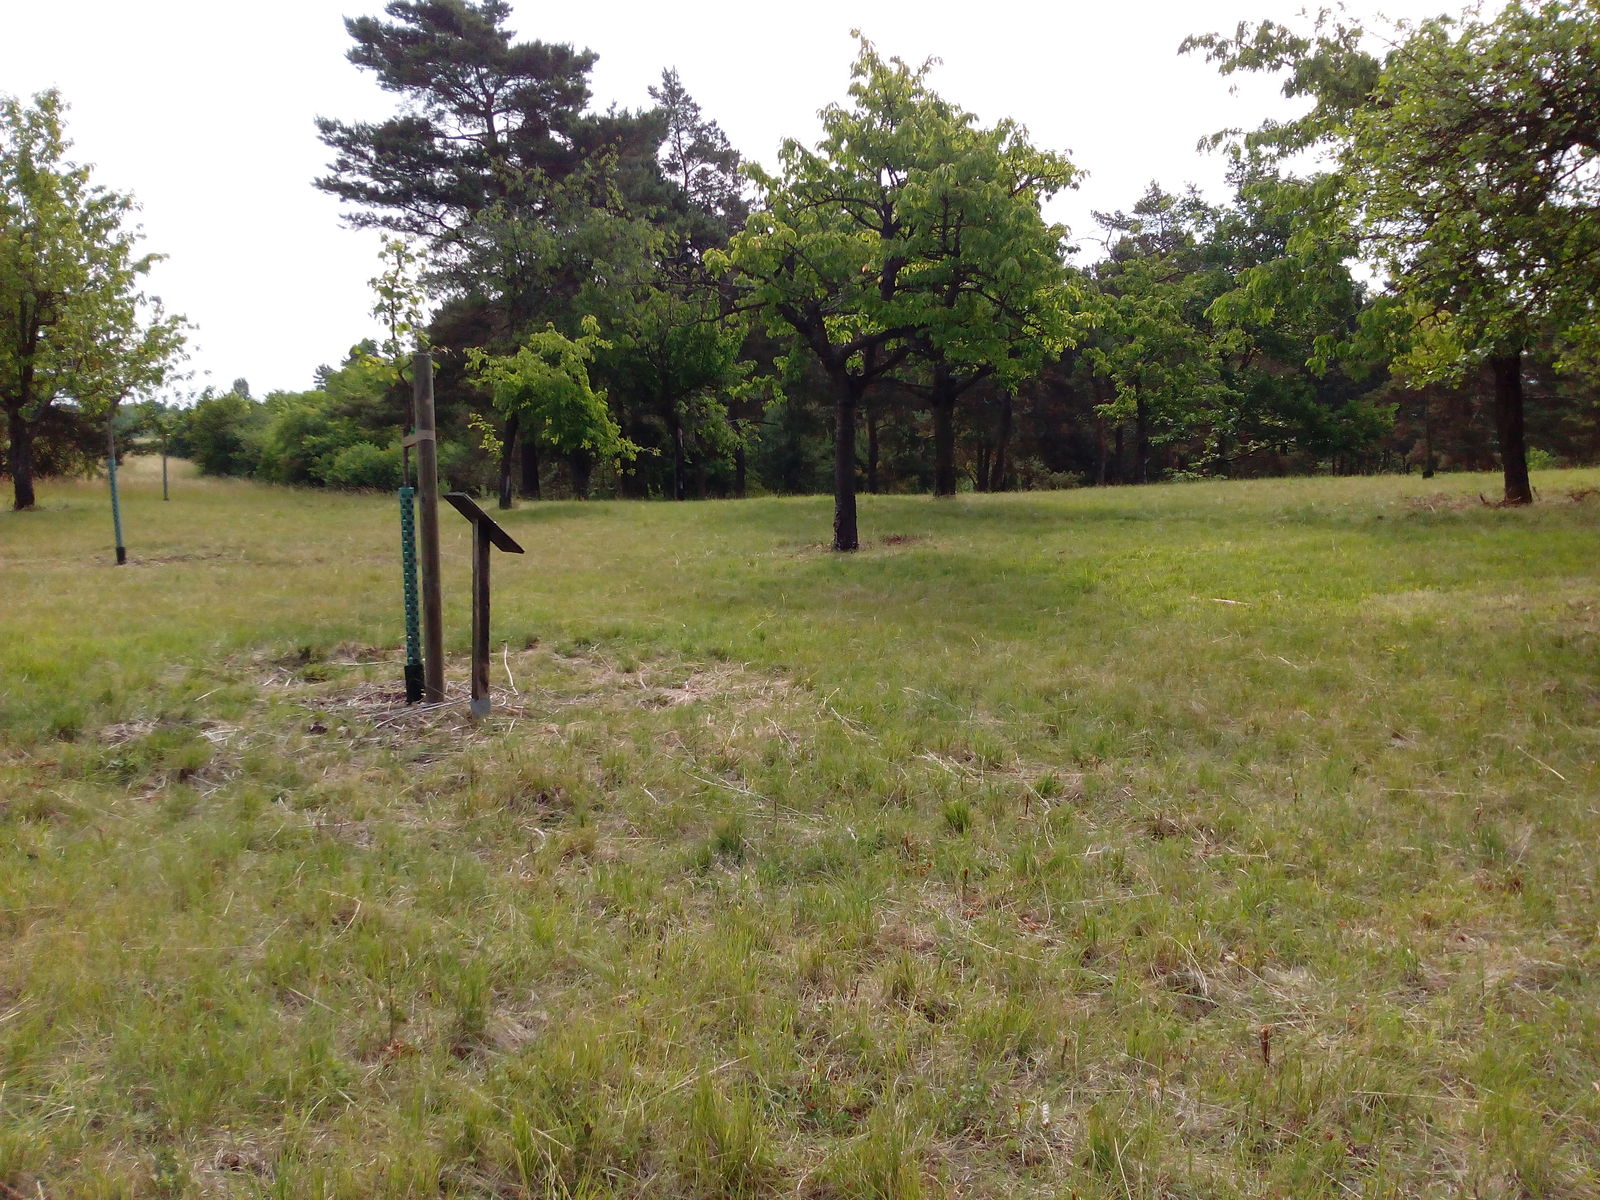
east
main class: Cropland
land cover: Apple fruit
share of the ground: 25 - 50 %
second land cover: Grassland without tree/shrub cover
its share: > 75 %
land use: Agriculture (excluding fallow land and kitchen gardens)
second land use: Amenities, museums, leisure
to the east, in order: Apple fruit; Grassland without tree/shrub cover; Grassland with sparse tree/shrub cover; Cherry fruit; Pine dominated coniferous woodland; Grassland with sparse tree/shrub cover; Tracks; Grassland with sparse tree/shrub cover; Tracks; Grassland with sparse tree/shrub cover; Other mixed woodland; Broadleaved woodland; Other mixed woodland; Tracks; Other mixed woodland
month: June
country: DE
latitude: 51.3656
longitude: 11.1057
